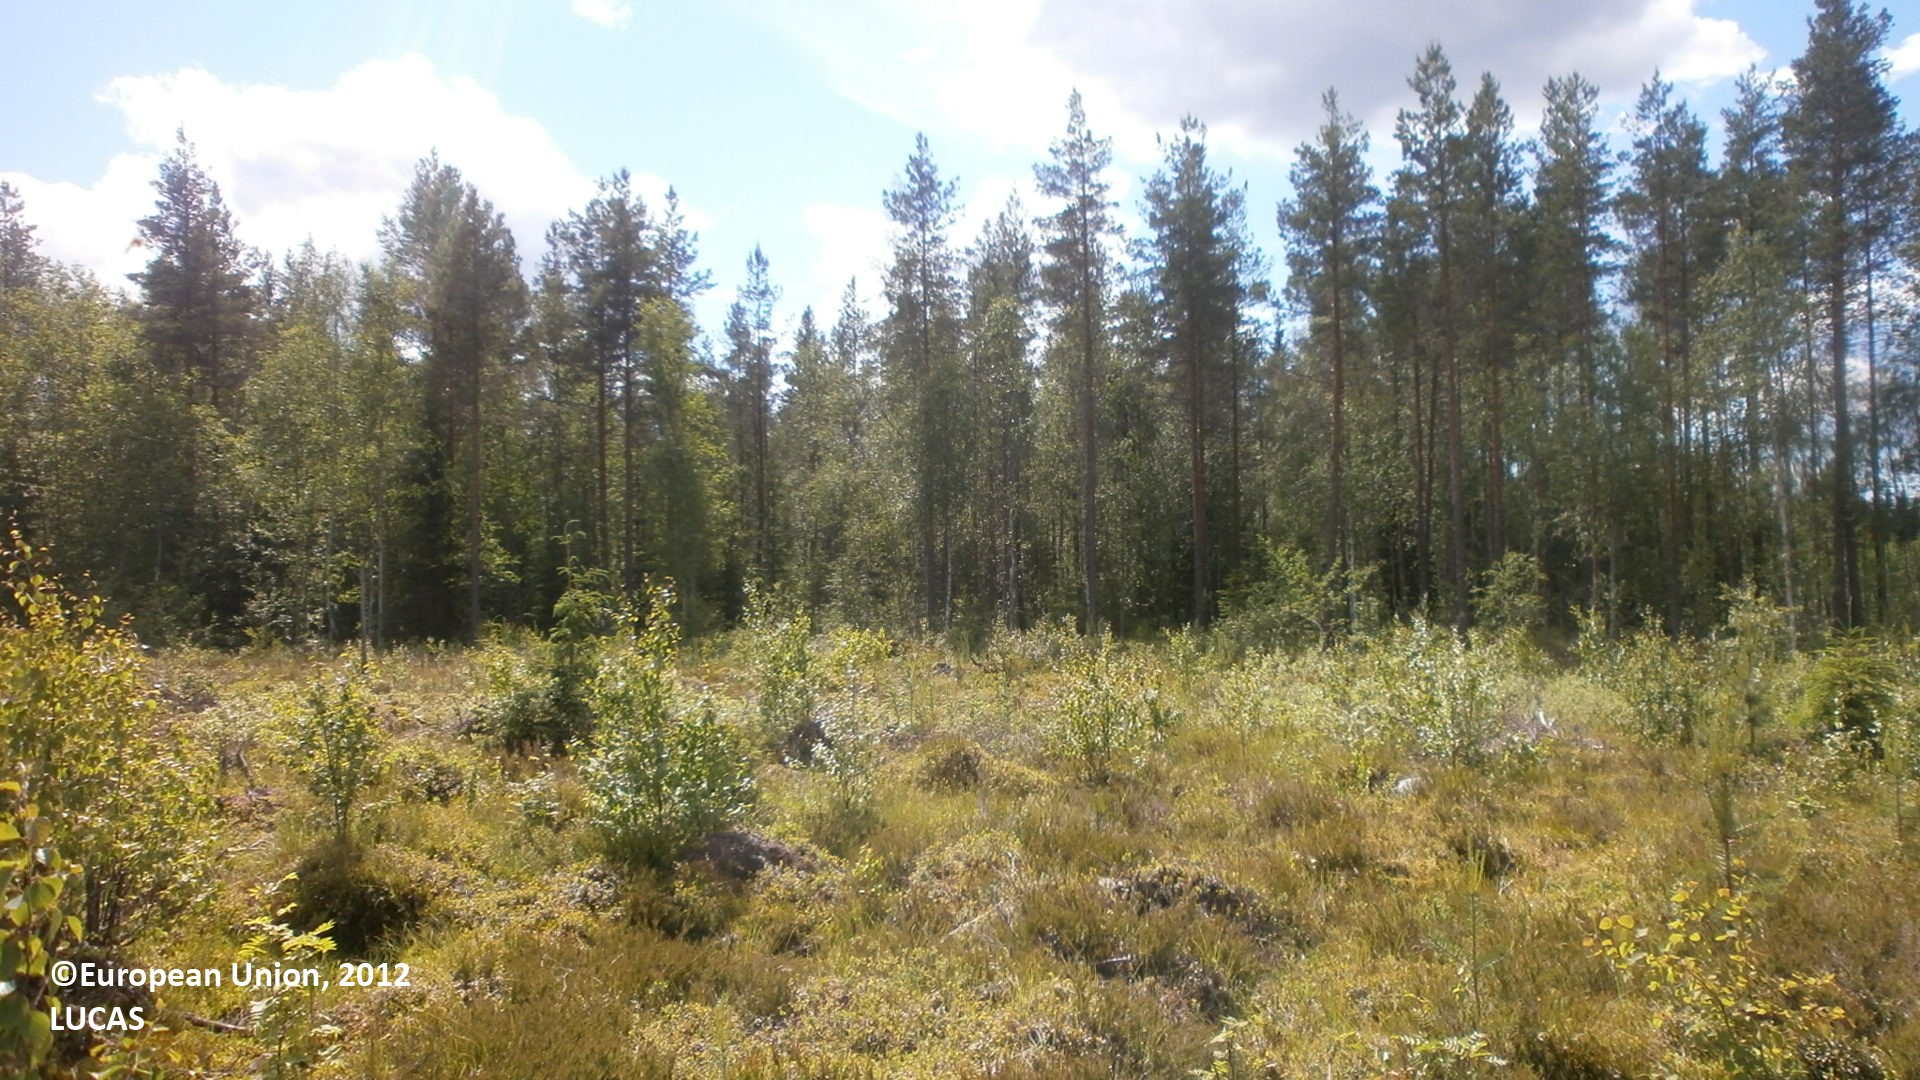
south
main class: Woodland
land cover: Other mixed woodland
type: boreal forest
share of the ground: 10 - 25 %
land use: Forestry
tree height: < 5 m
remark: Clear cut
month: July
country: FI
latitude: 64.1250
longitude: 24.9726
